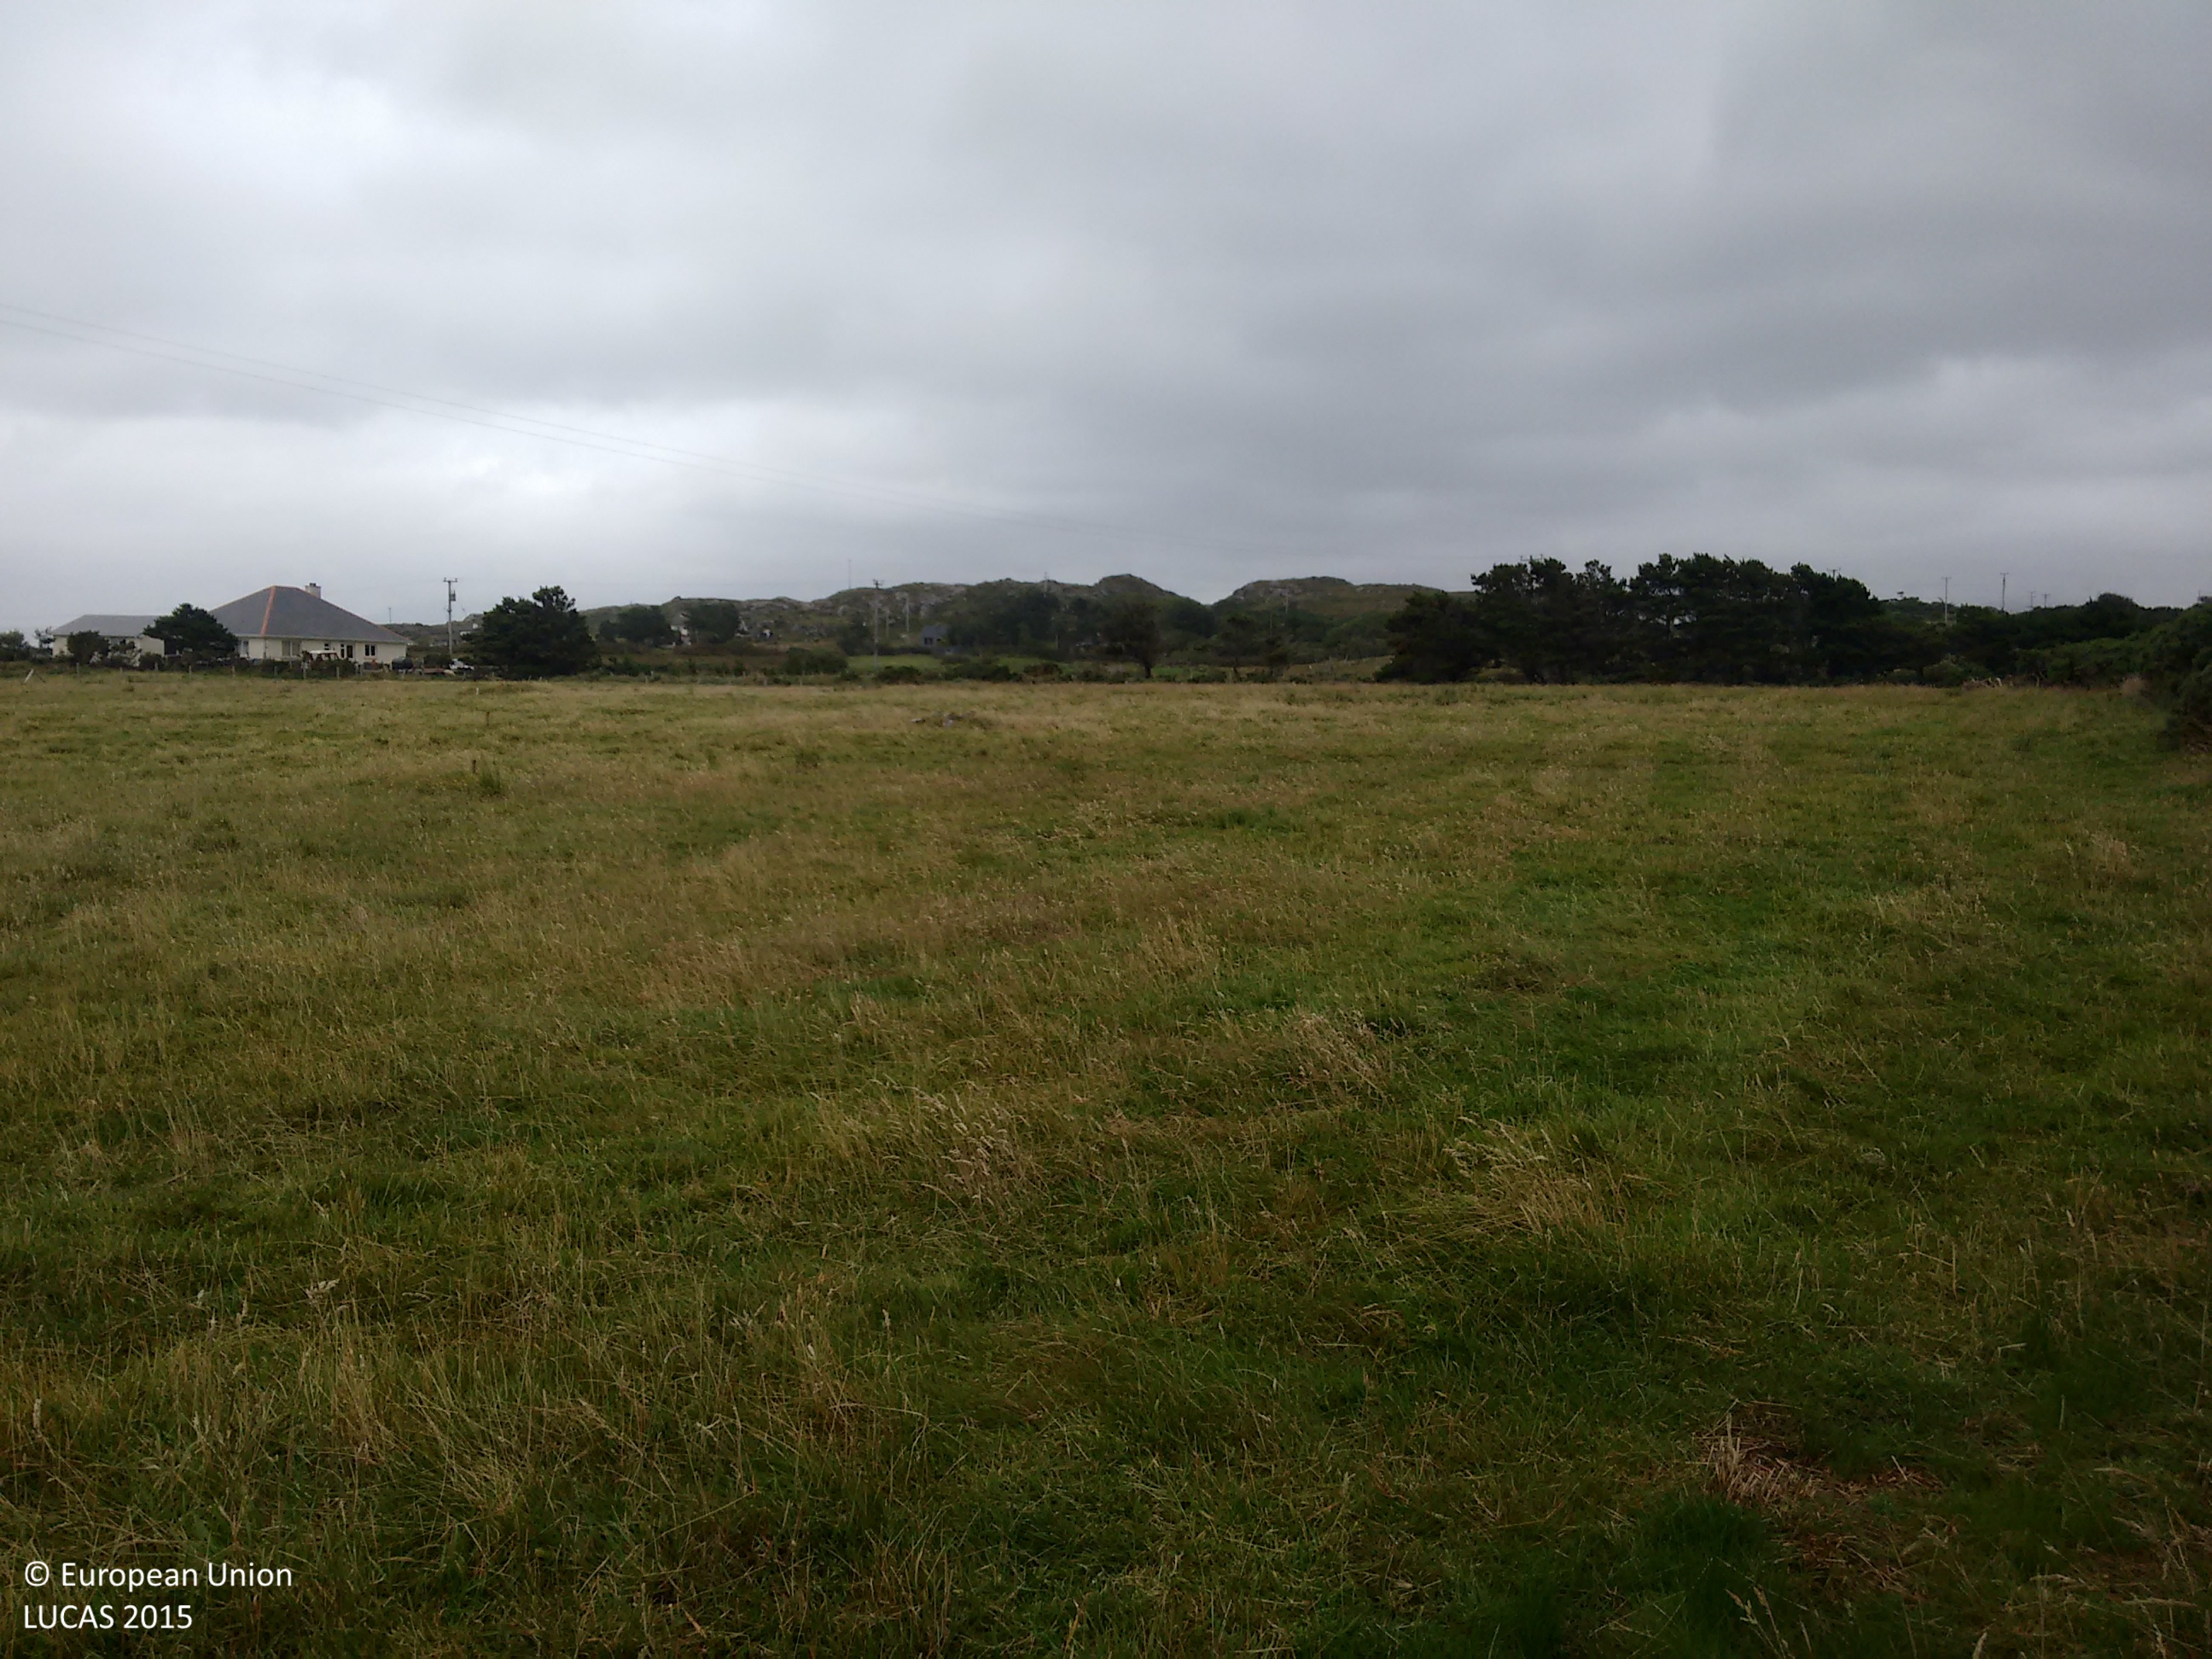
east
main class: Grassland
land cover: Grassland without tree/shrub cover
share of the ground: > 75 %
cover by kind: herbaceous plants 90 %, unconsolidated bare surface 10 %
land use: Agriculture (excluding fallow land and kitchen gardens)
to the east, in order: Grassland without tree/shrub cover; Fences; Ditches and canals; Fences; Grassland without tree/shrub cover; Electric lines; Grassland without tree/shrub cover; Shrubland without tree cover; Ditches and canals; Fences; Pine dominated coniferous woodland; Grassland without tree/shrub cover; Electric lines; Grassland without tree/shrub cover; Ditches and canals; Artificial constructions; Fences; Grassland with sparse tree/shrub cover
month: August
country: IE
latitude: 53.6005
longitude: -10.0043
